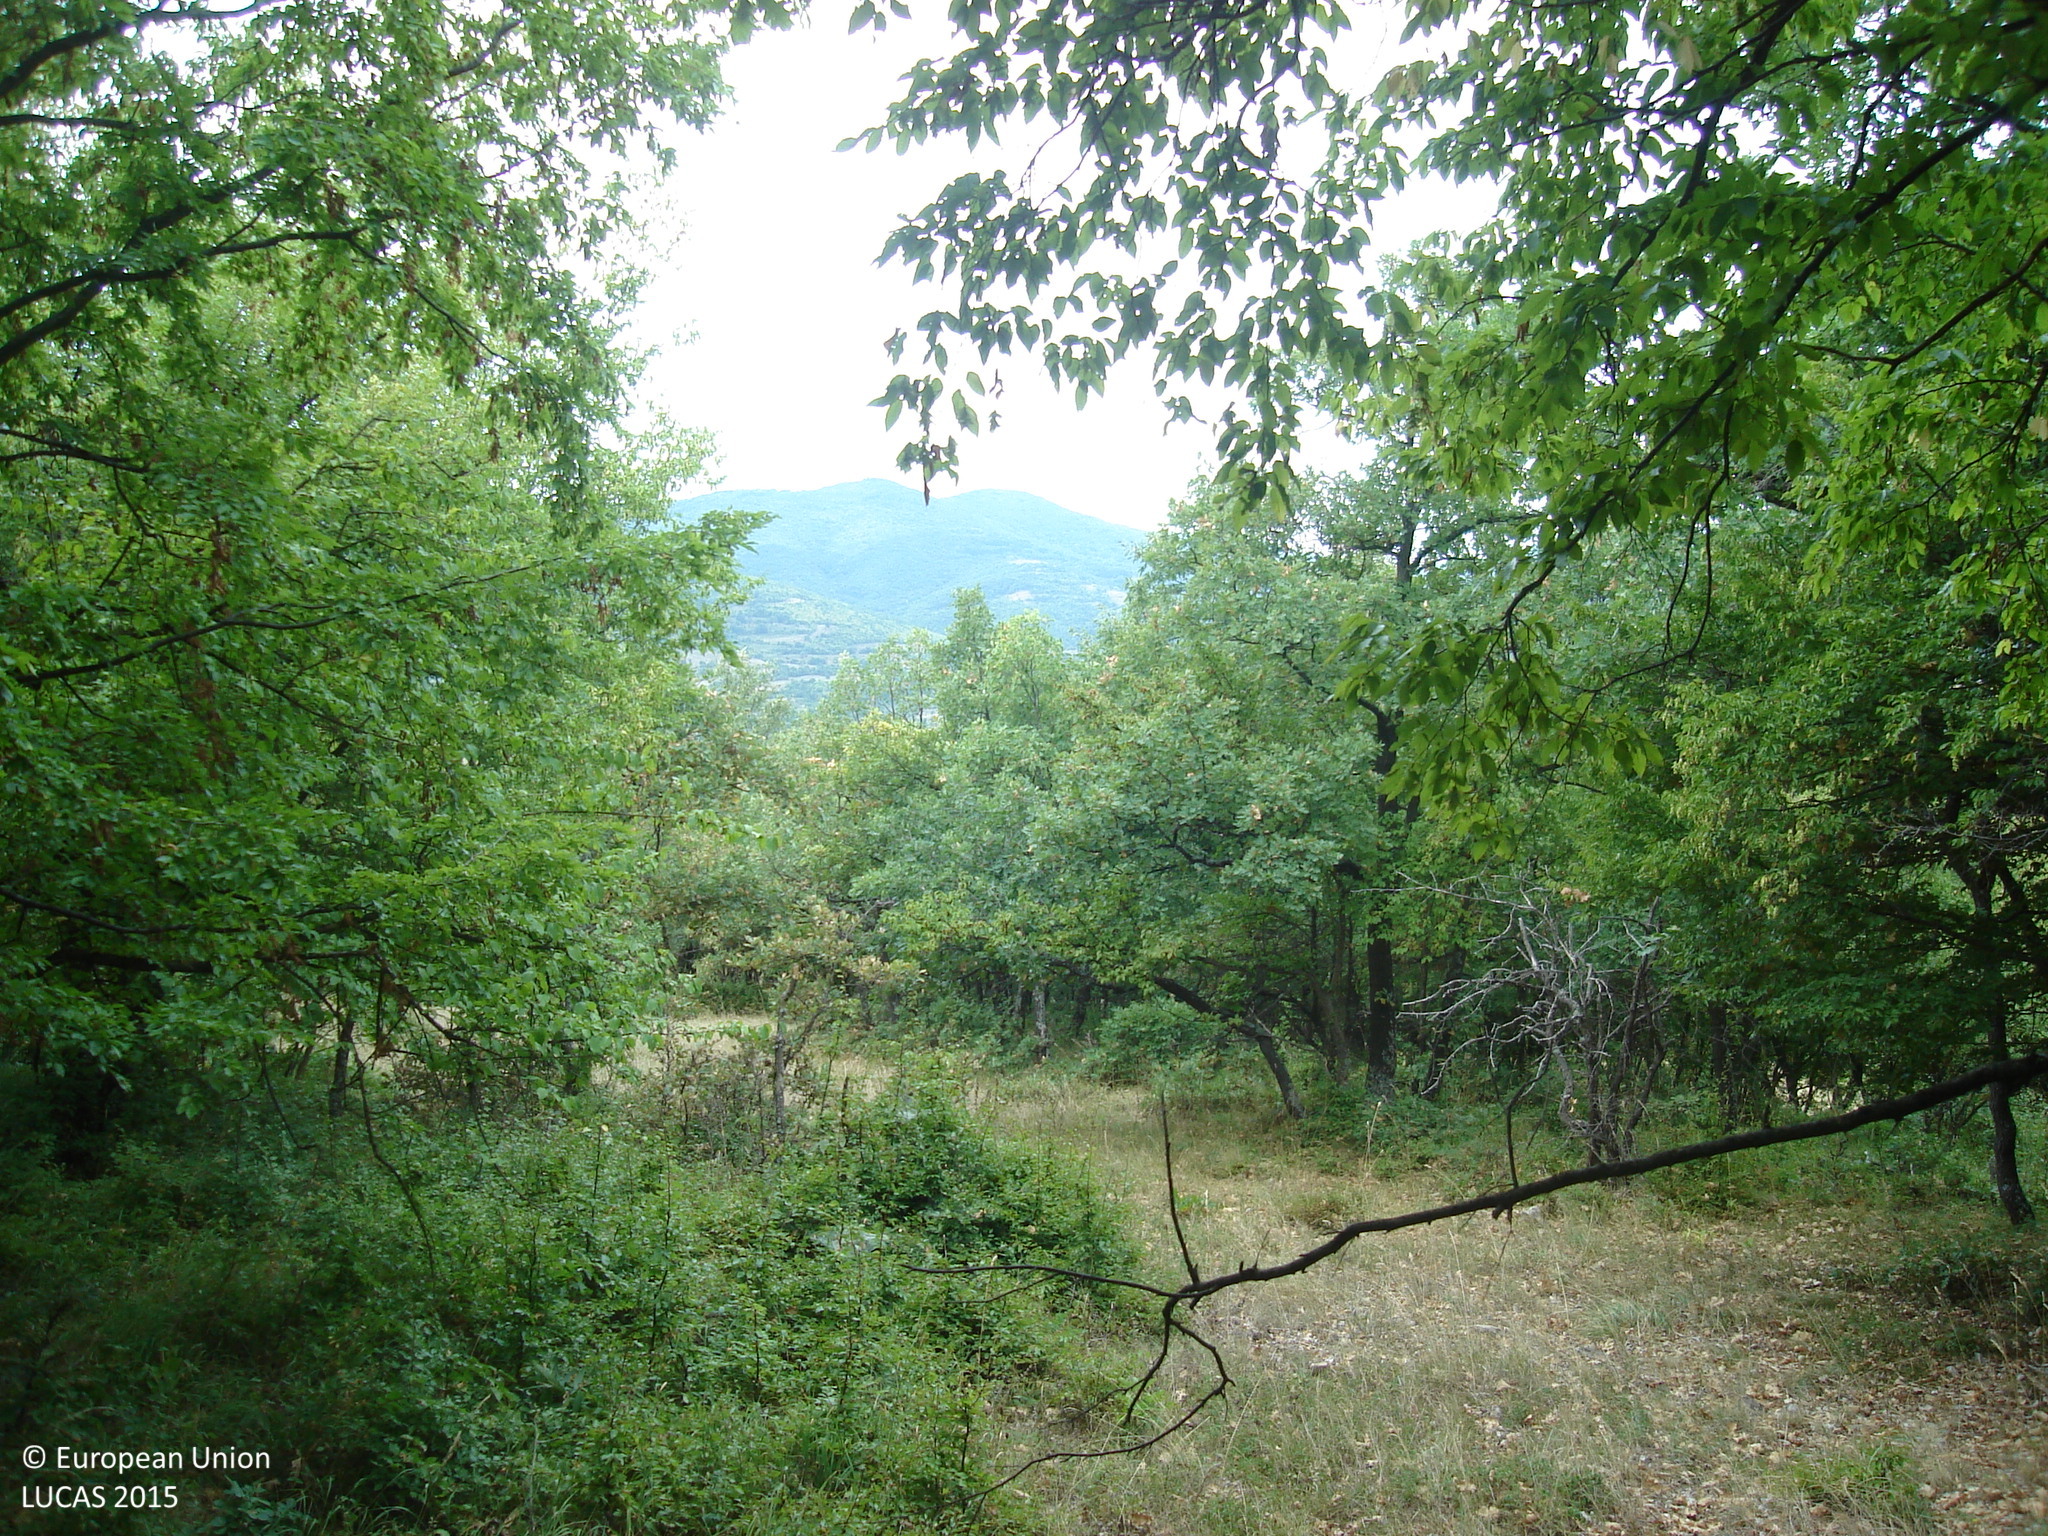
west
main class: Woodland
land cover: Broadleaved woodland
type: thermophilous deciduous forest
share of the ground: 50 - 75 %
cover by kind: broadleaved forest trees 65 %, herbaceous plants 25 %, shrubs 5 %, consolidated bare surface 5 %
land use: Forestry
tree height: > 5 m
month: September
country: BG
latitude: 42.6515
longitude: 23.9615
